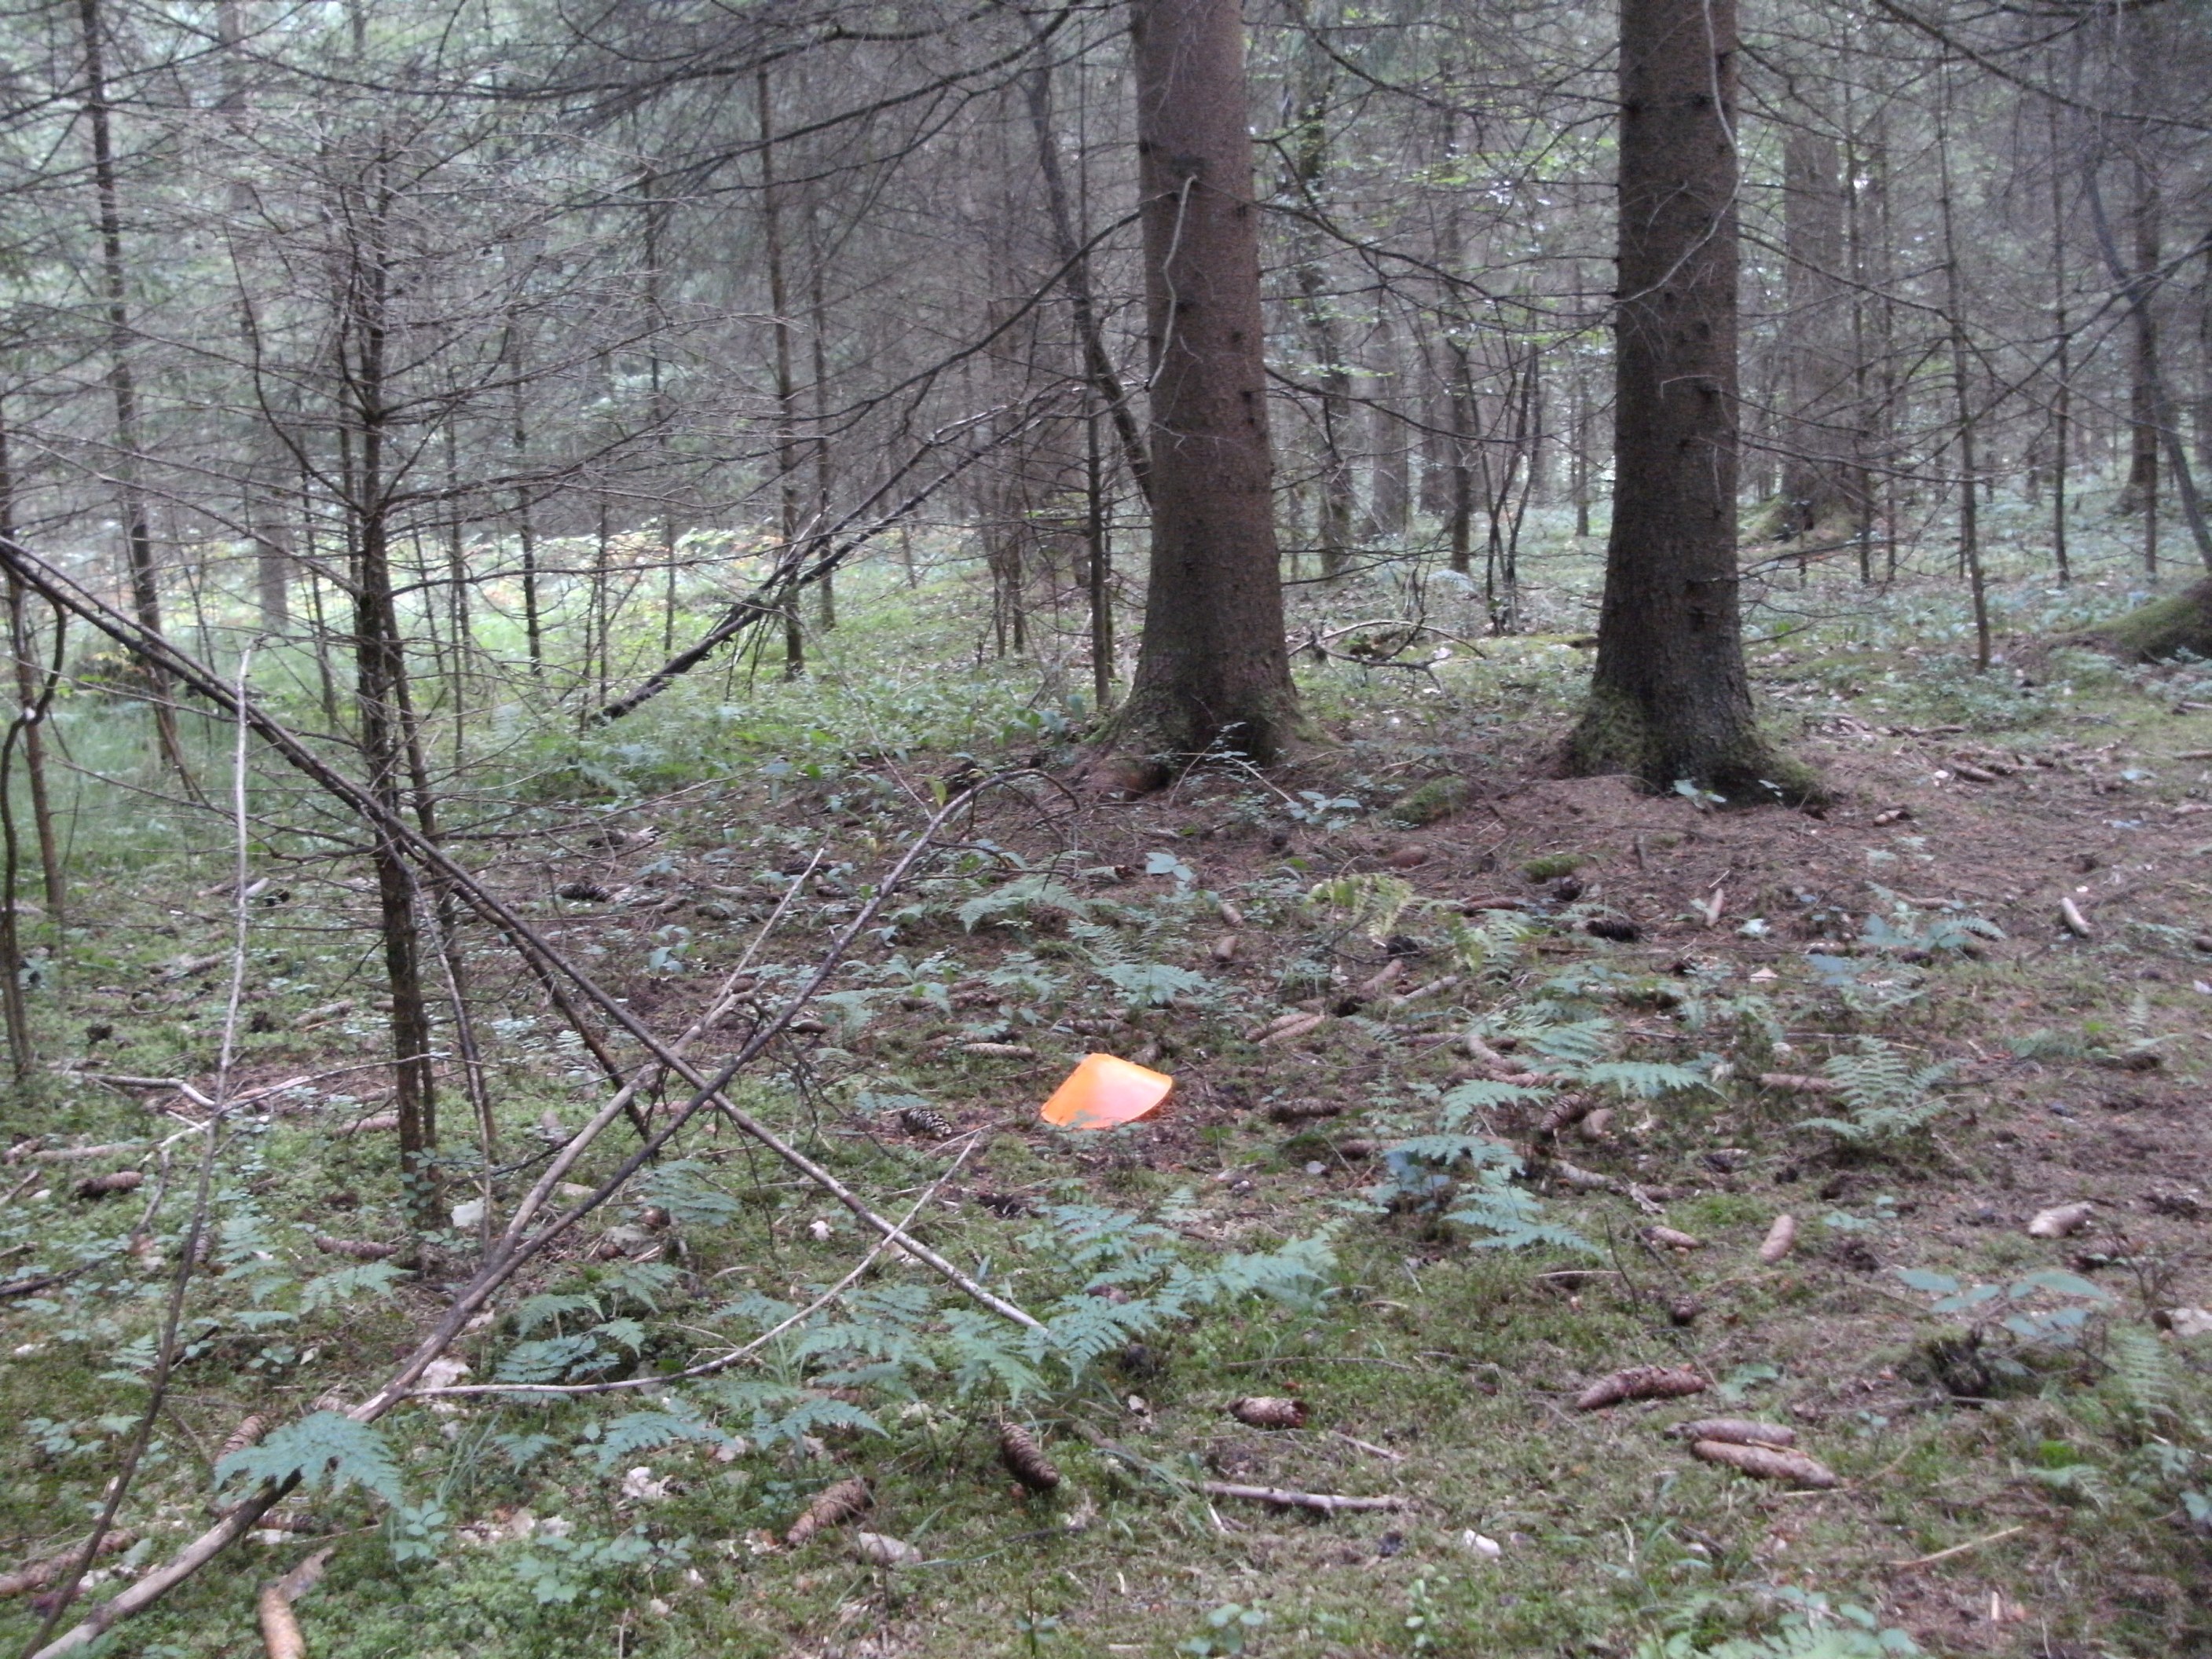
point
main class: Woodland
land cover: Spruce dominated coniferous woodland
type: hemiboreal forest and nemoral coniferous forest and mixed broadleaved-coniferous forest
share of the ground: > 75 %
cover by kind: coniferous forest trees 75 %, broadleaved forest trees 15 %, shrubs 5 %, herbaceous plants 5 %
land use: Forestry
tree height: > 5 m
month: July
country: AT
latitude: 46.6059
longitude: 14.7631
